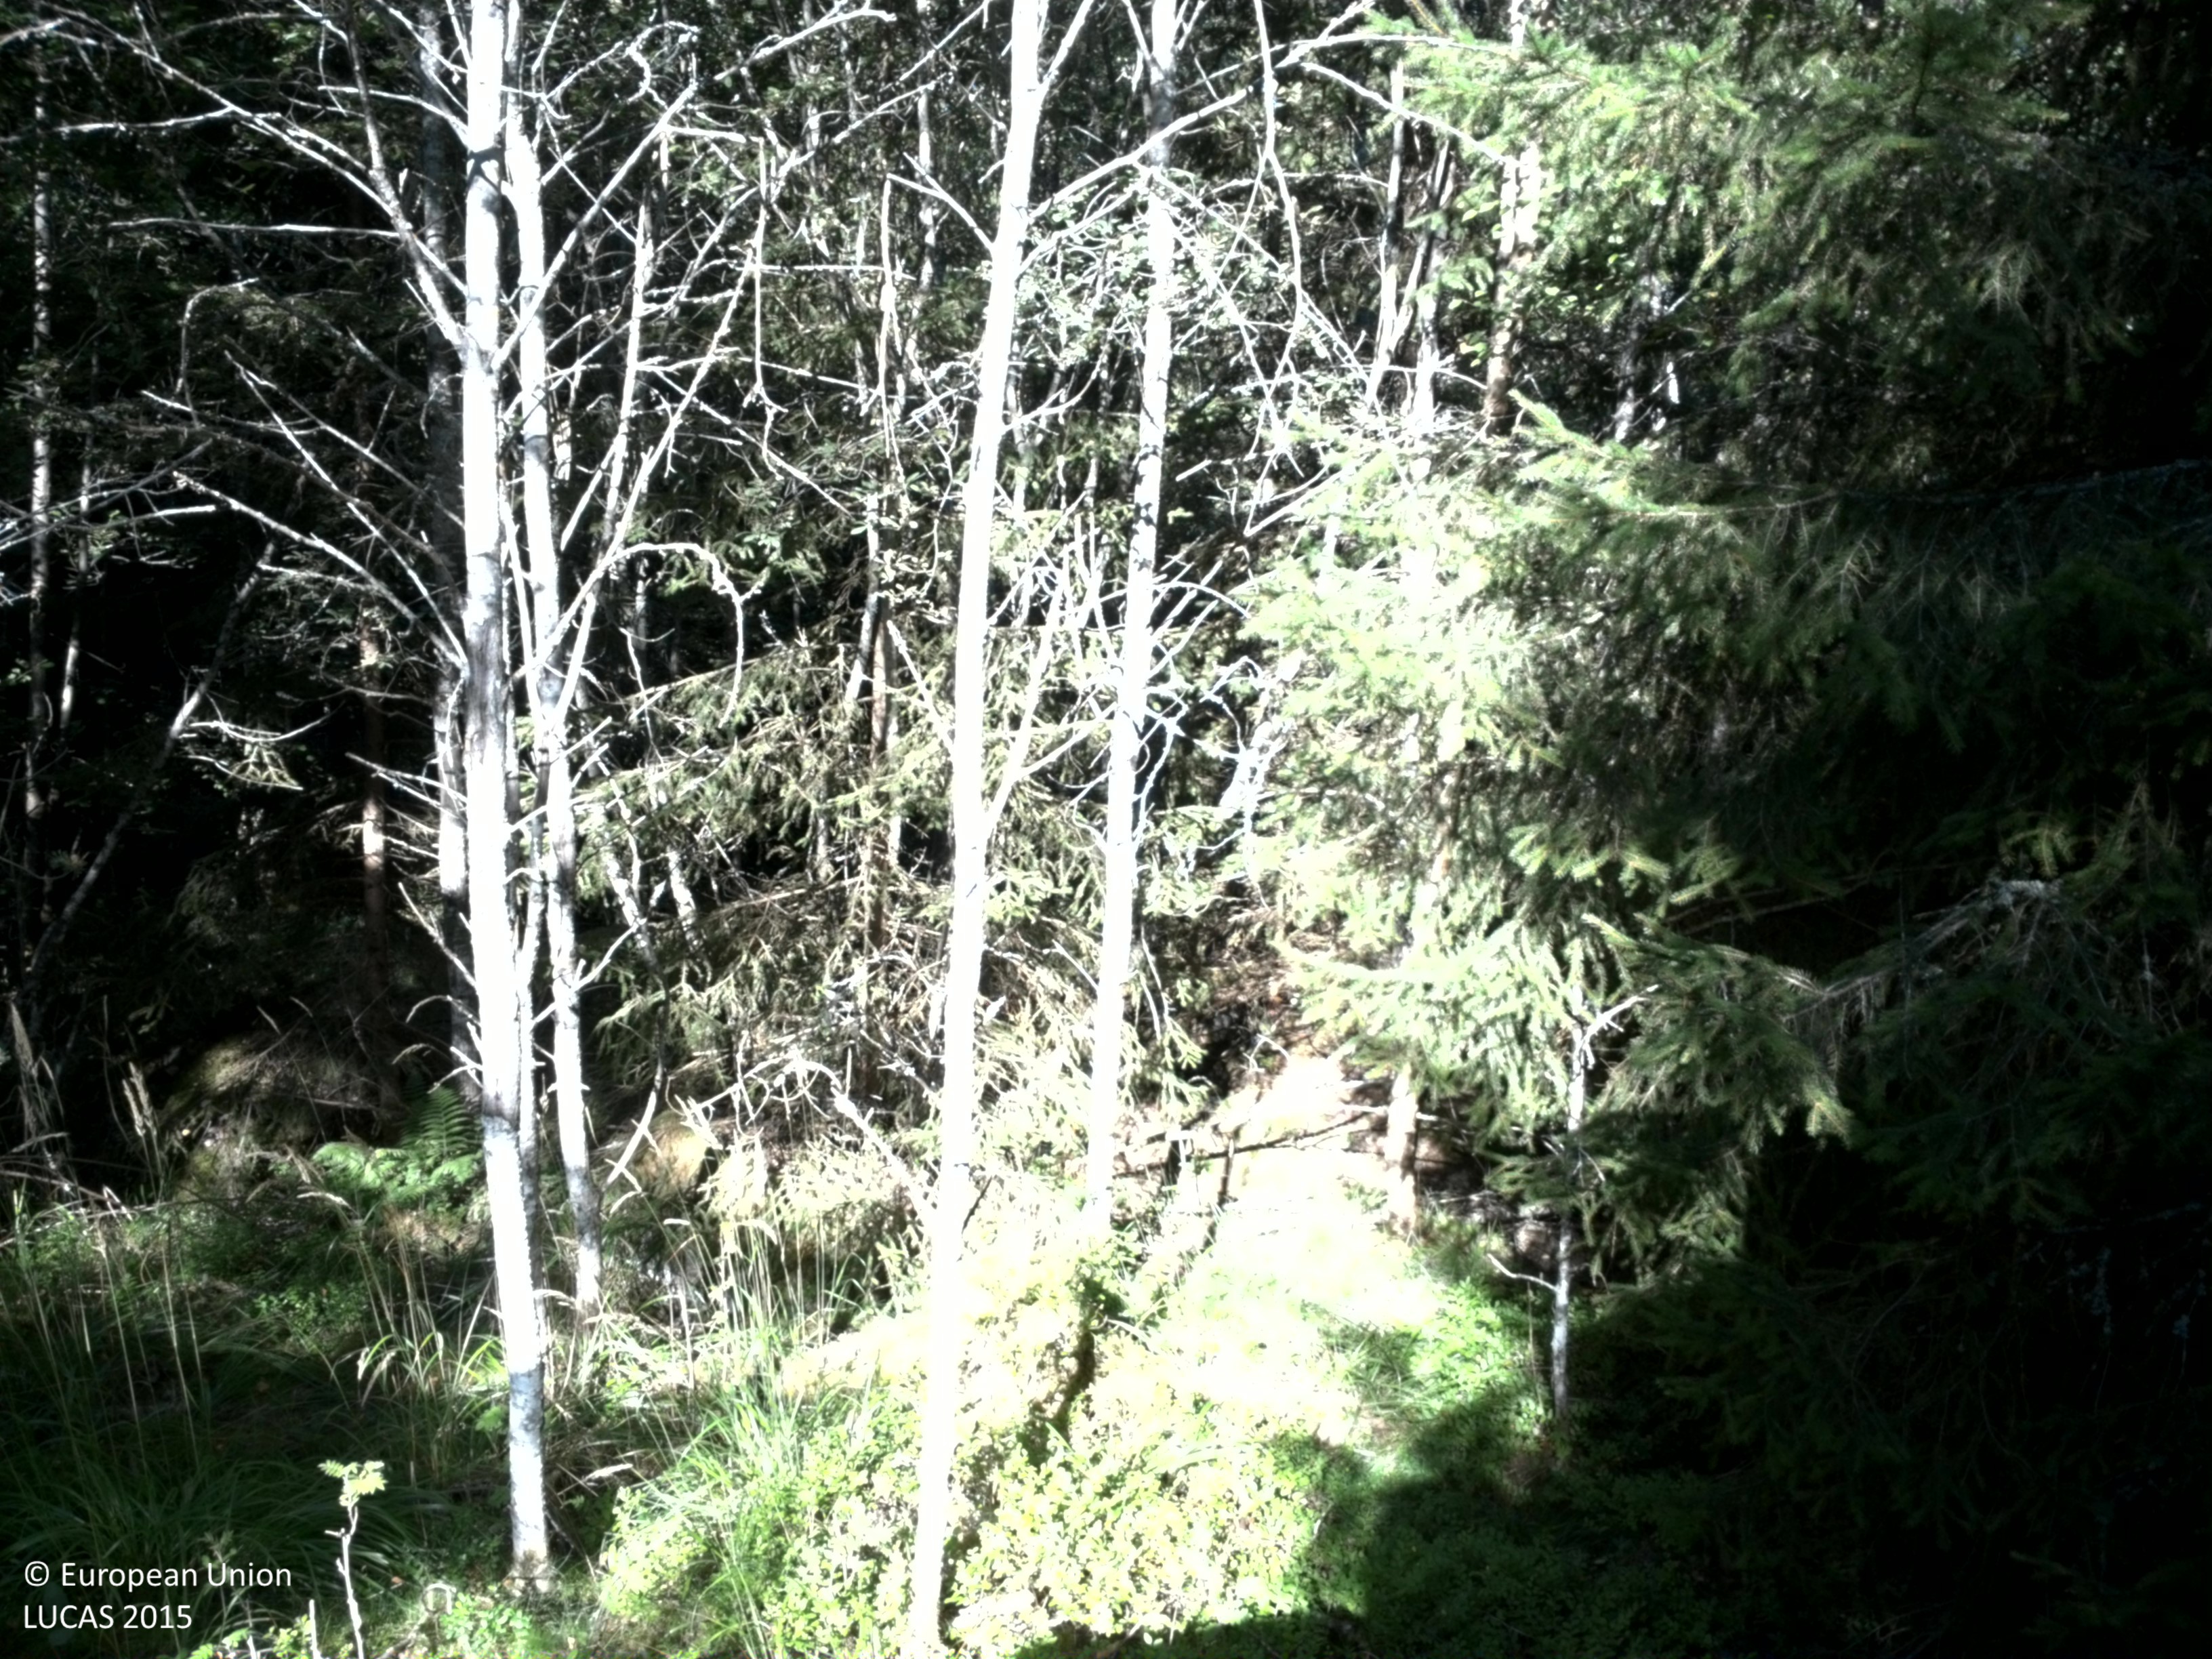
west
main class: Woodland
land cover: Spruce dominated mixed woodland
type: boreal forest
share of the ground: 50 - 75 %
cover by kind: coniferous forest trees 45 %, broadleaved forest trees 30 %, lichens and mosses 15 %, herbaceous plants 10 %
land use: Forestry
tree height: > 5 m
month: August
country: SE
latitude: 59.7669
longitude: 17.7762
